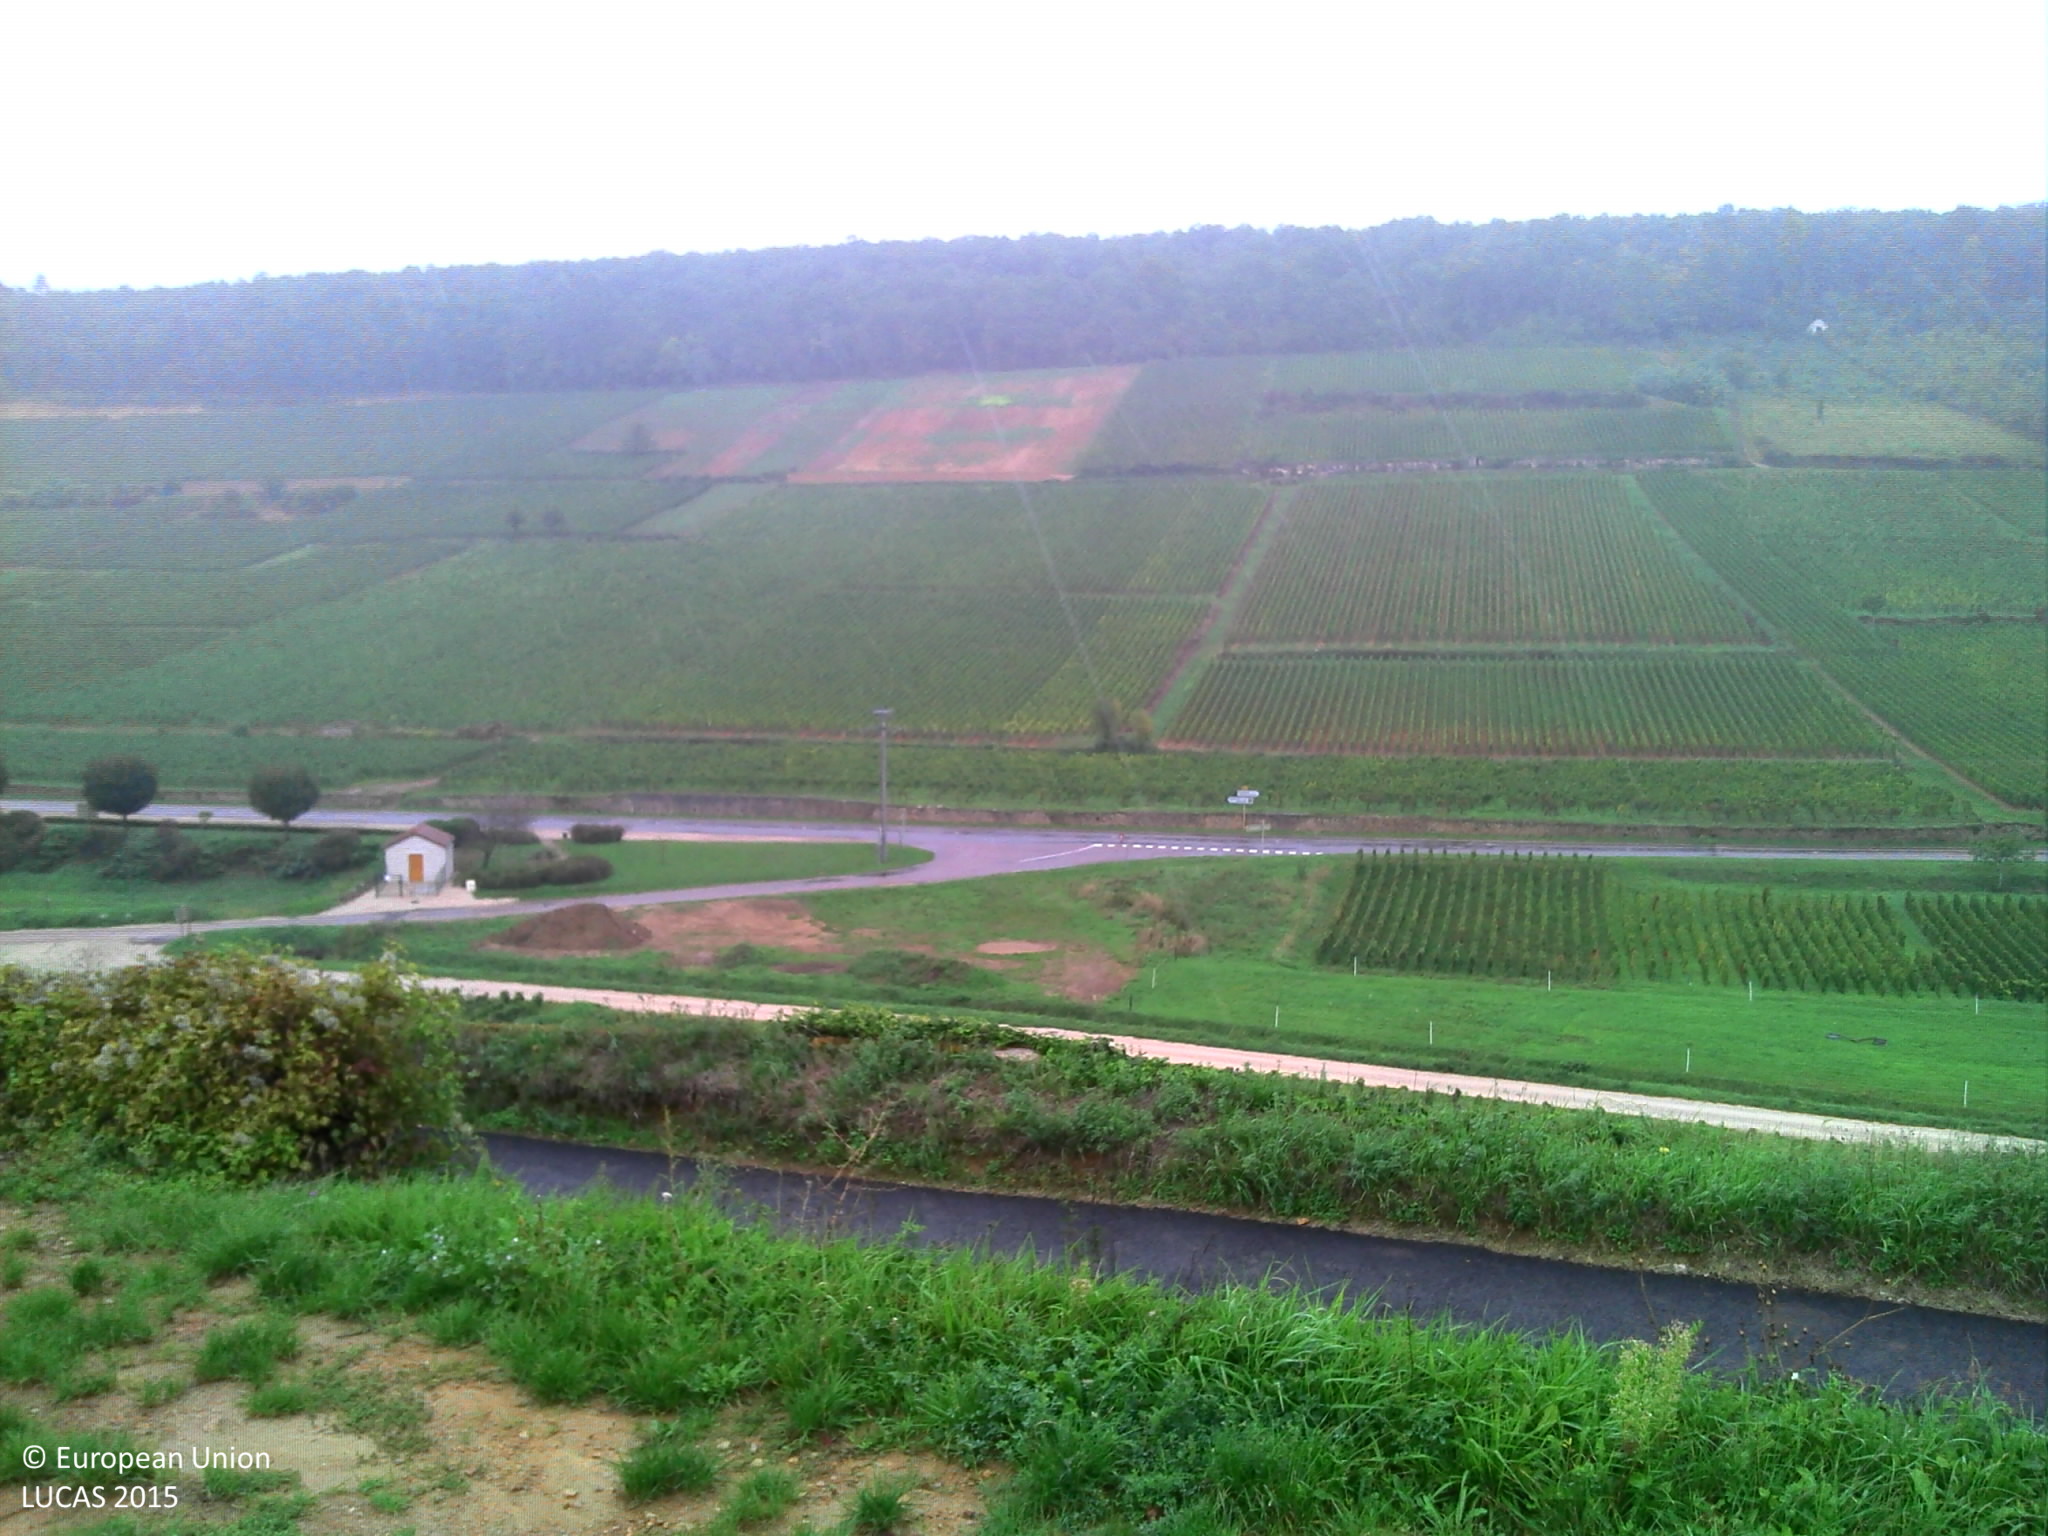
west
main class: Cropland
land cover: Vineyards
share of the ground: 10 - 25 %
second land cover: Other bare soil
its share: > 75 %
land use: Agriculture (excluding fallow land and kitchen gardens)
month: September
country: FR
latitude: 47.0753
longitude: 4.8514
